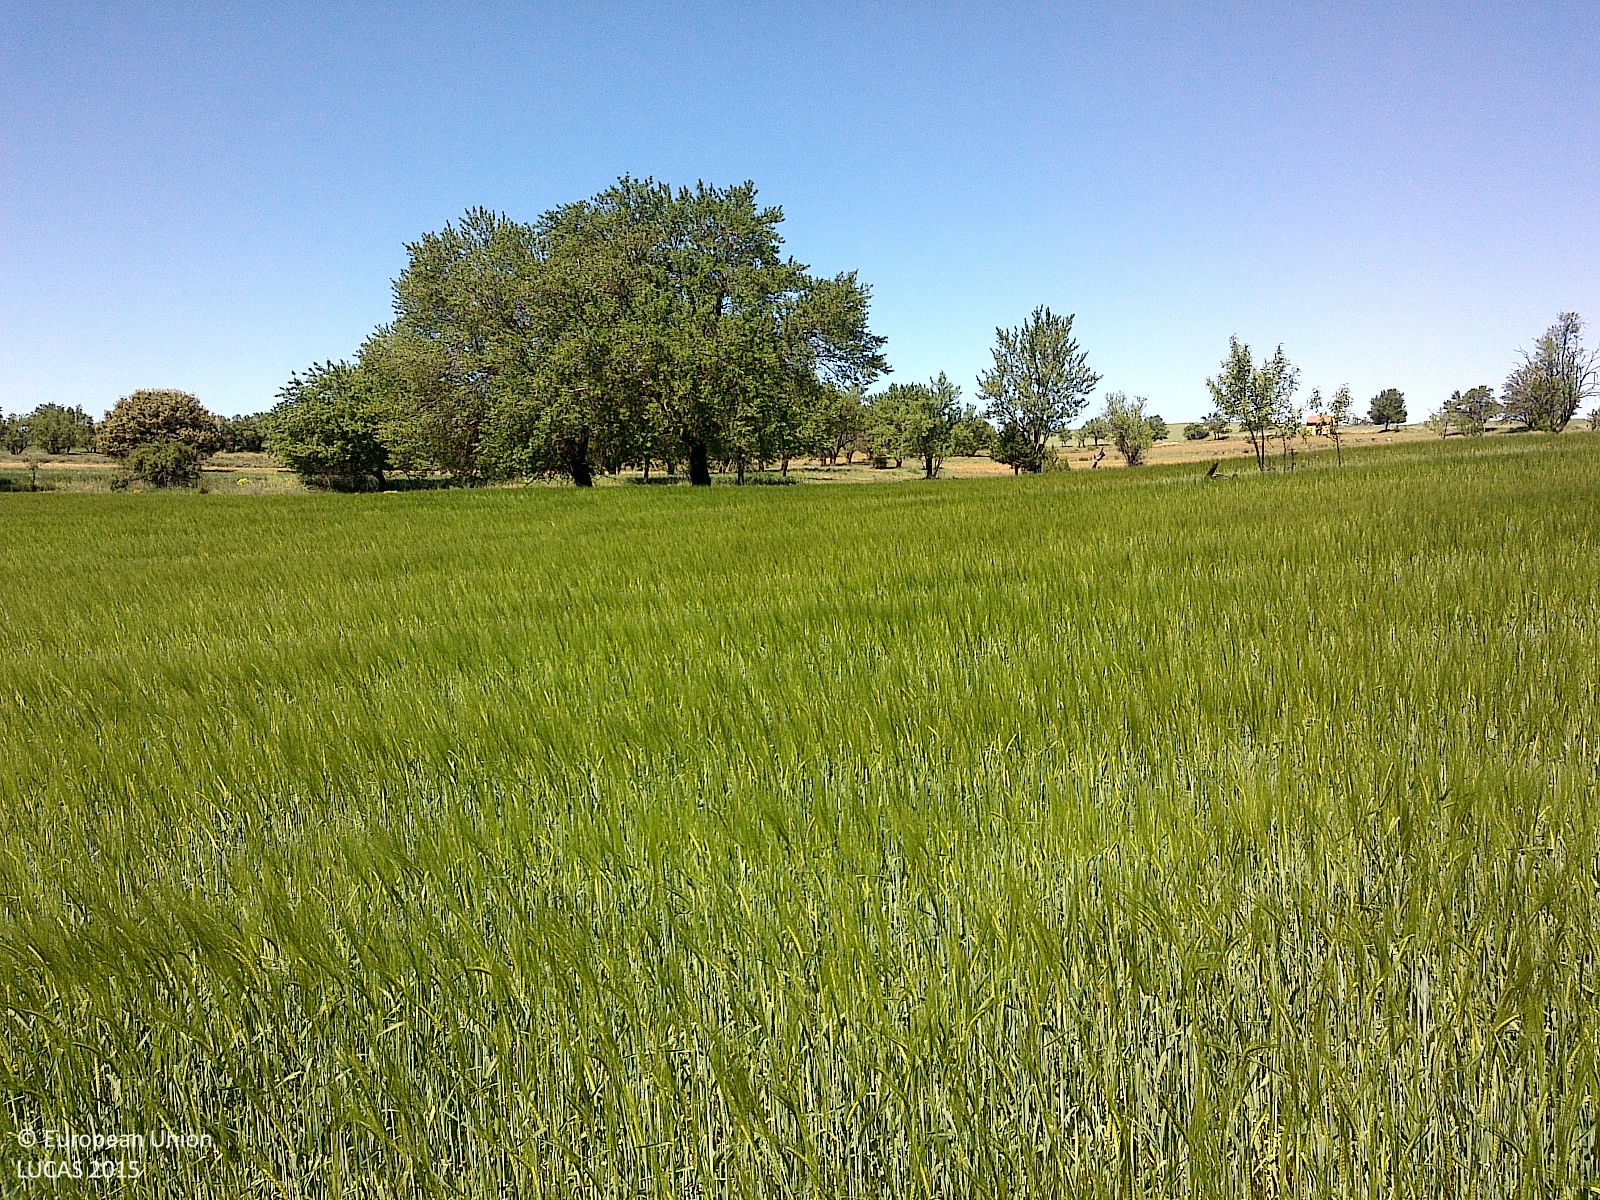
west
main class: Cropland
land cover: Barley
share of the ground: > 75 %
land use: Agriculture (excluding fallow land and kitchen gardens)
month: May
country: ES
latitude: 41.5614
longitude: -3.1015
